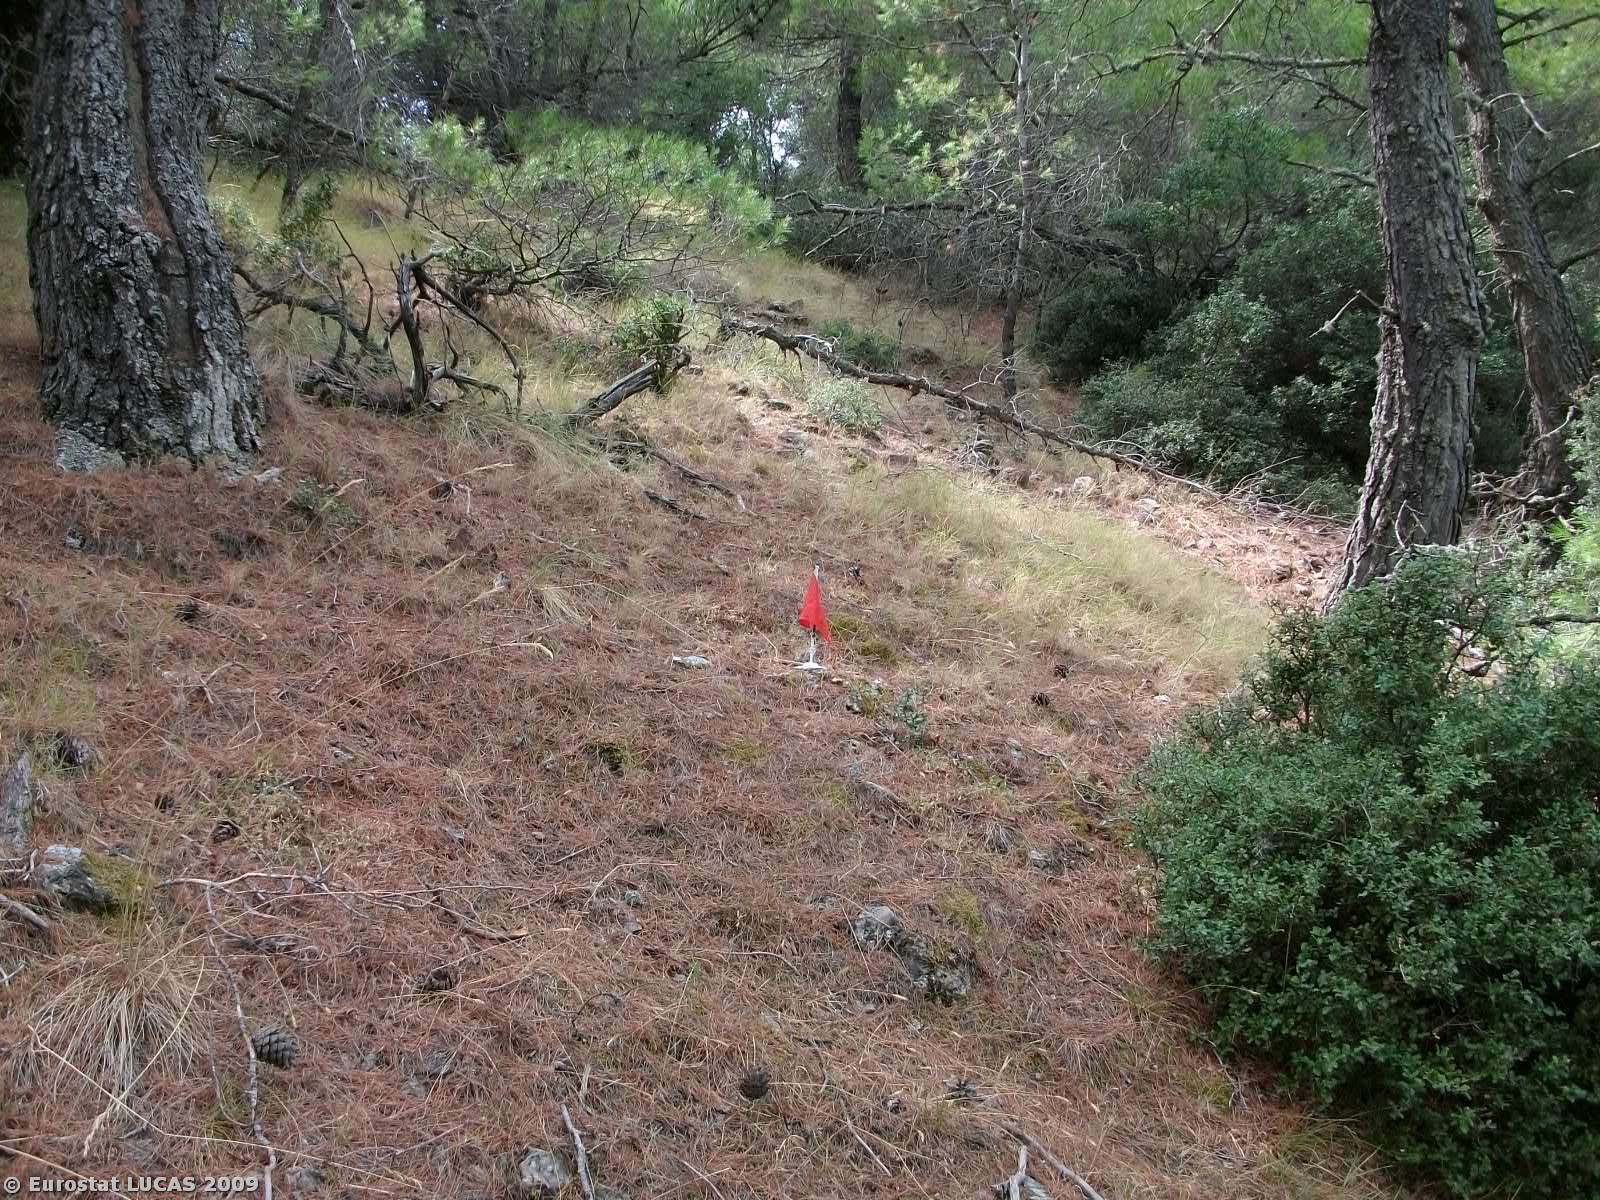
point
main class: Woodland
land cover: Coniferous woodland
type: coniferous forest of the mediterranean region
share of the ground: > 75 %
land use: Forestry
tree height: > 5 m
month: September
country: GR
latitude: 38.0045
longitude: 23.0138
